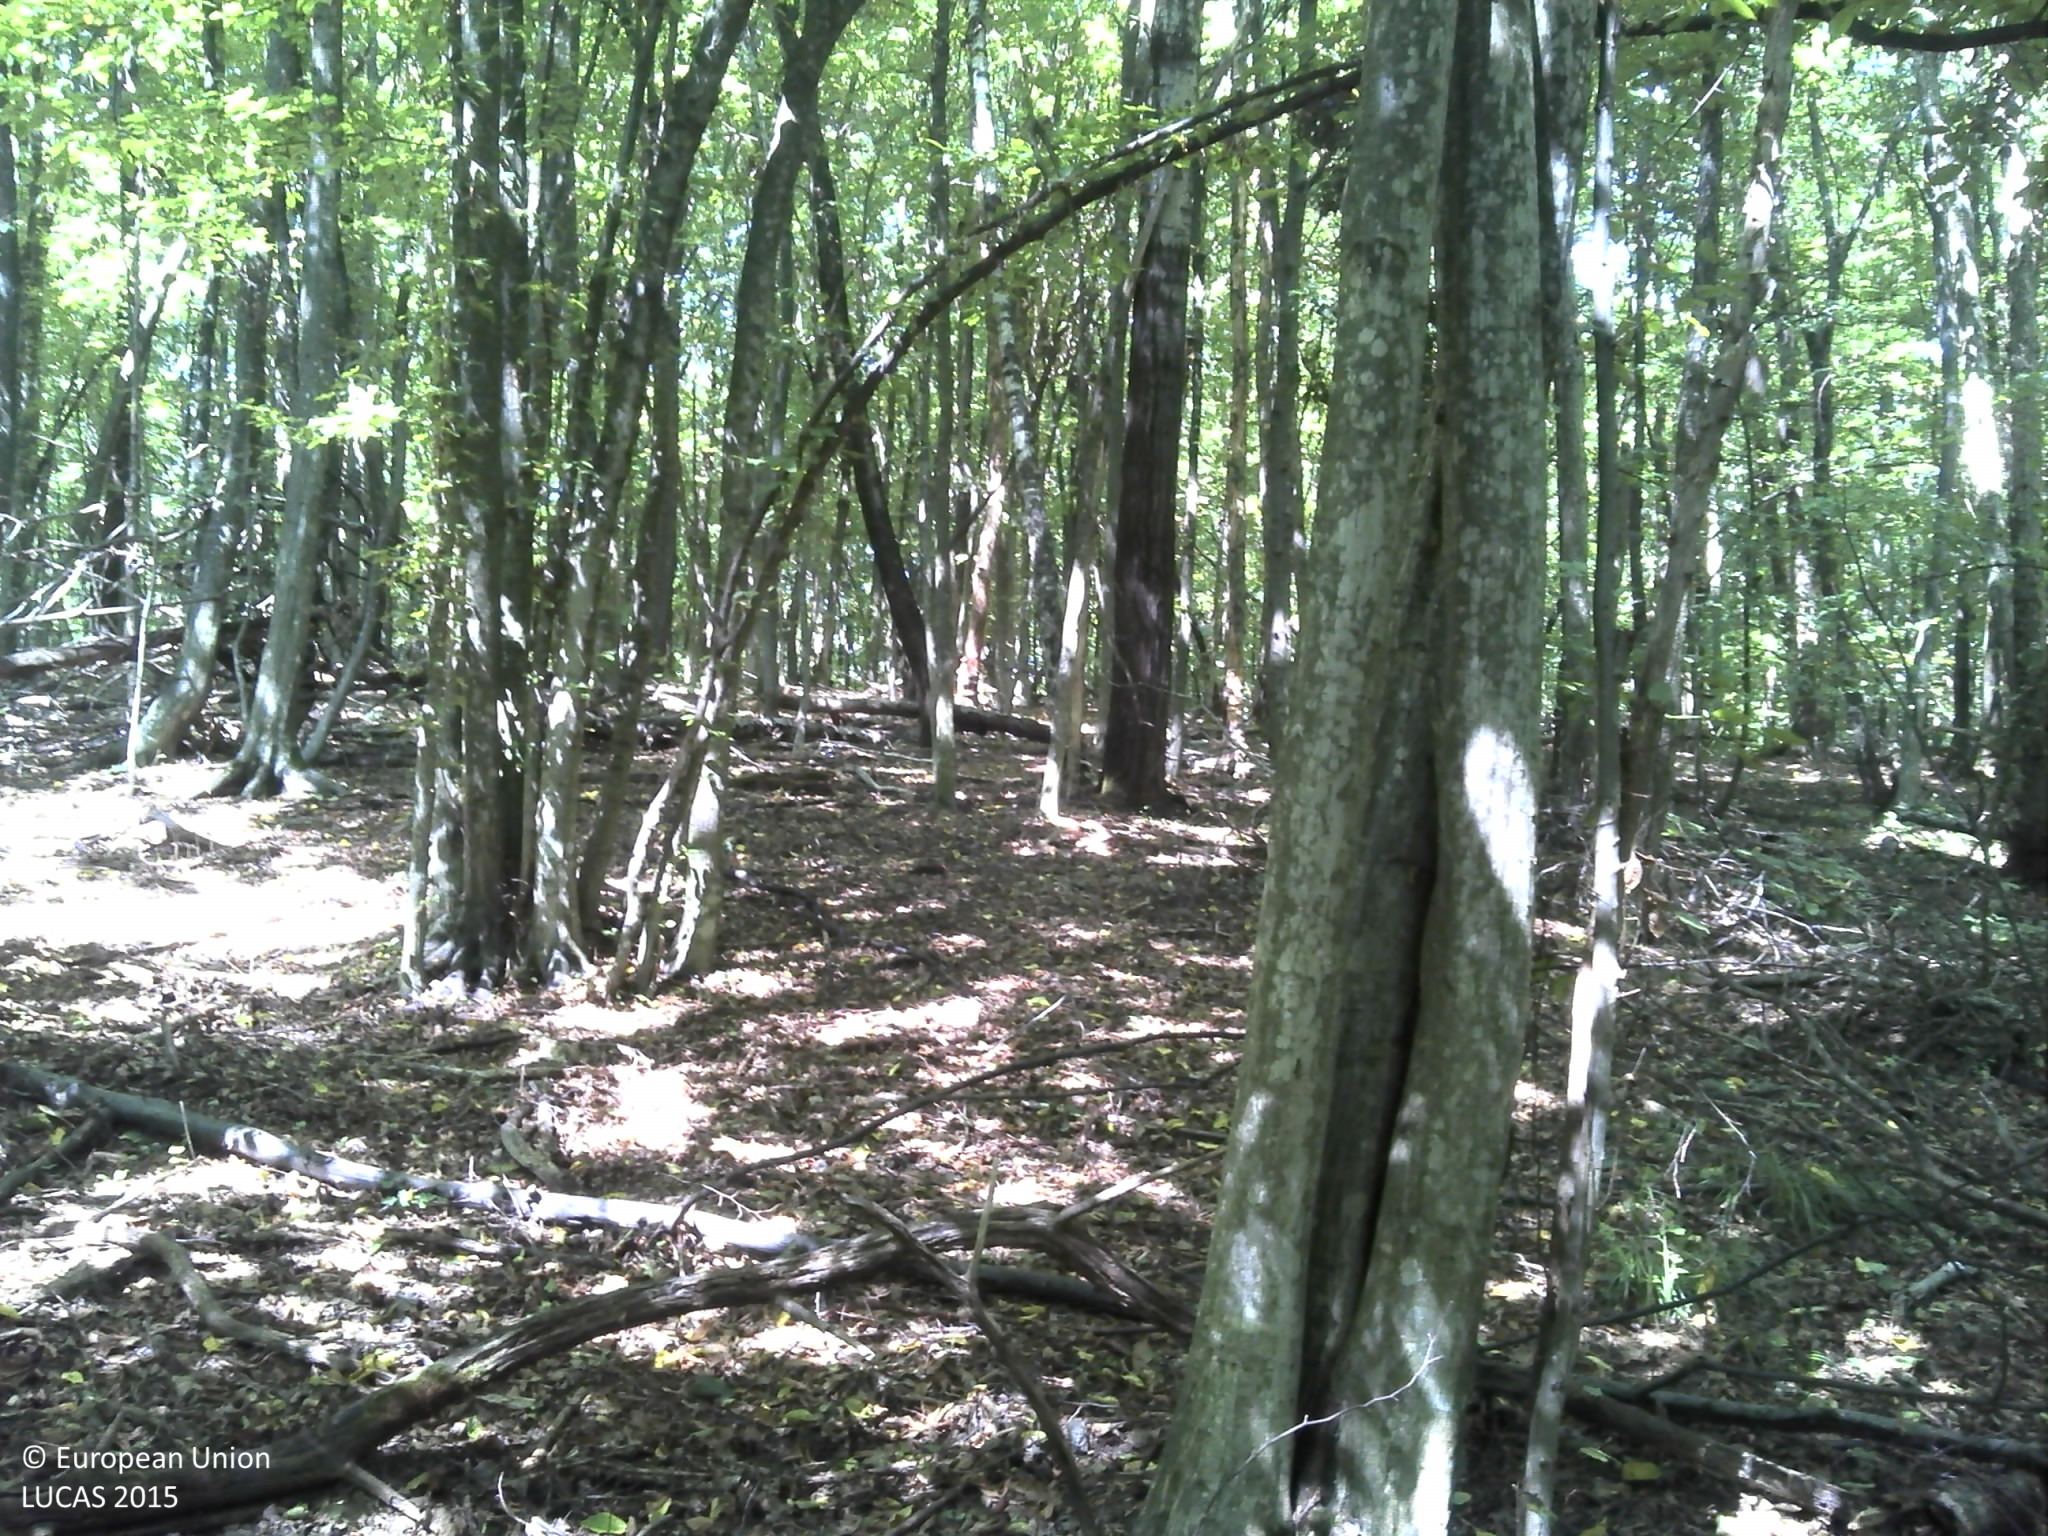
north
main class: Woodland
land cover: Broadleaved woodland
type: beech forest
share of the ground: > 75 %
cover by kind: broadleaved forest trees 100 %
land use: Forestry
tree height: > 5 m
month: August
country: HR
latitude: 45.2540
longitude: 16.4321
